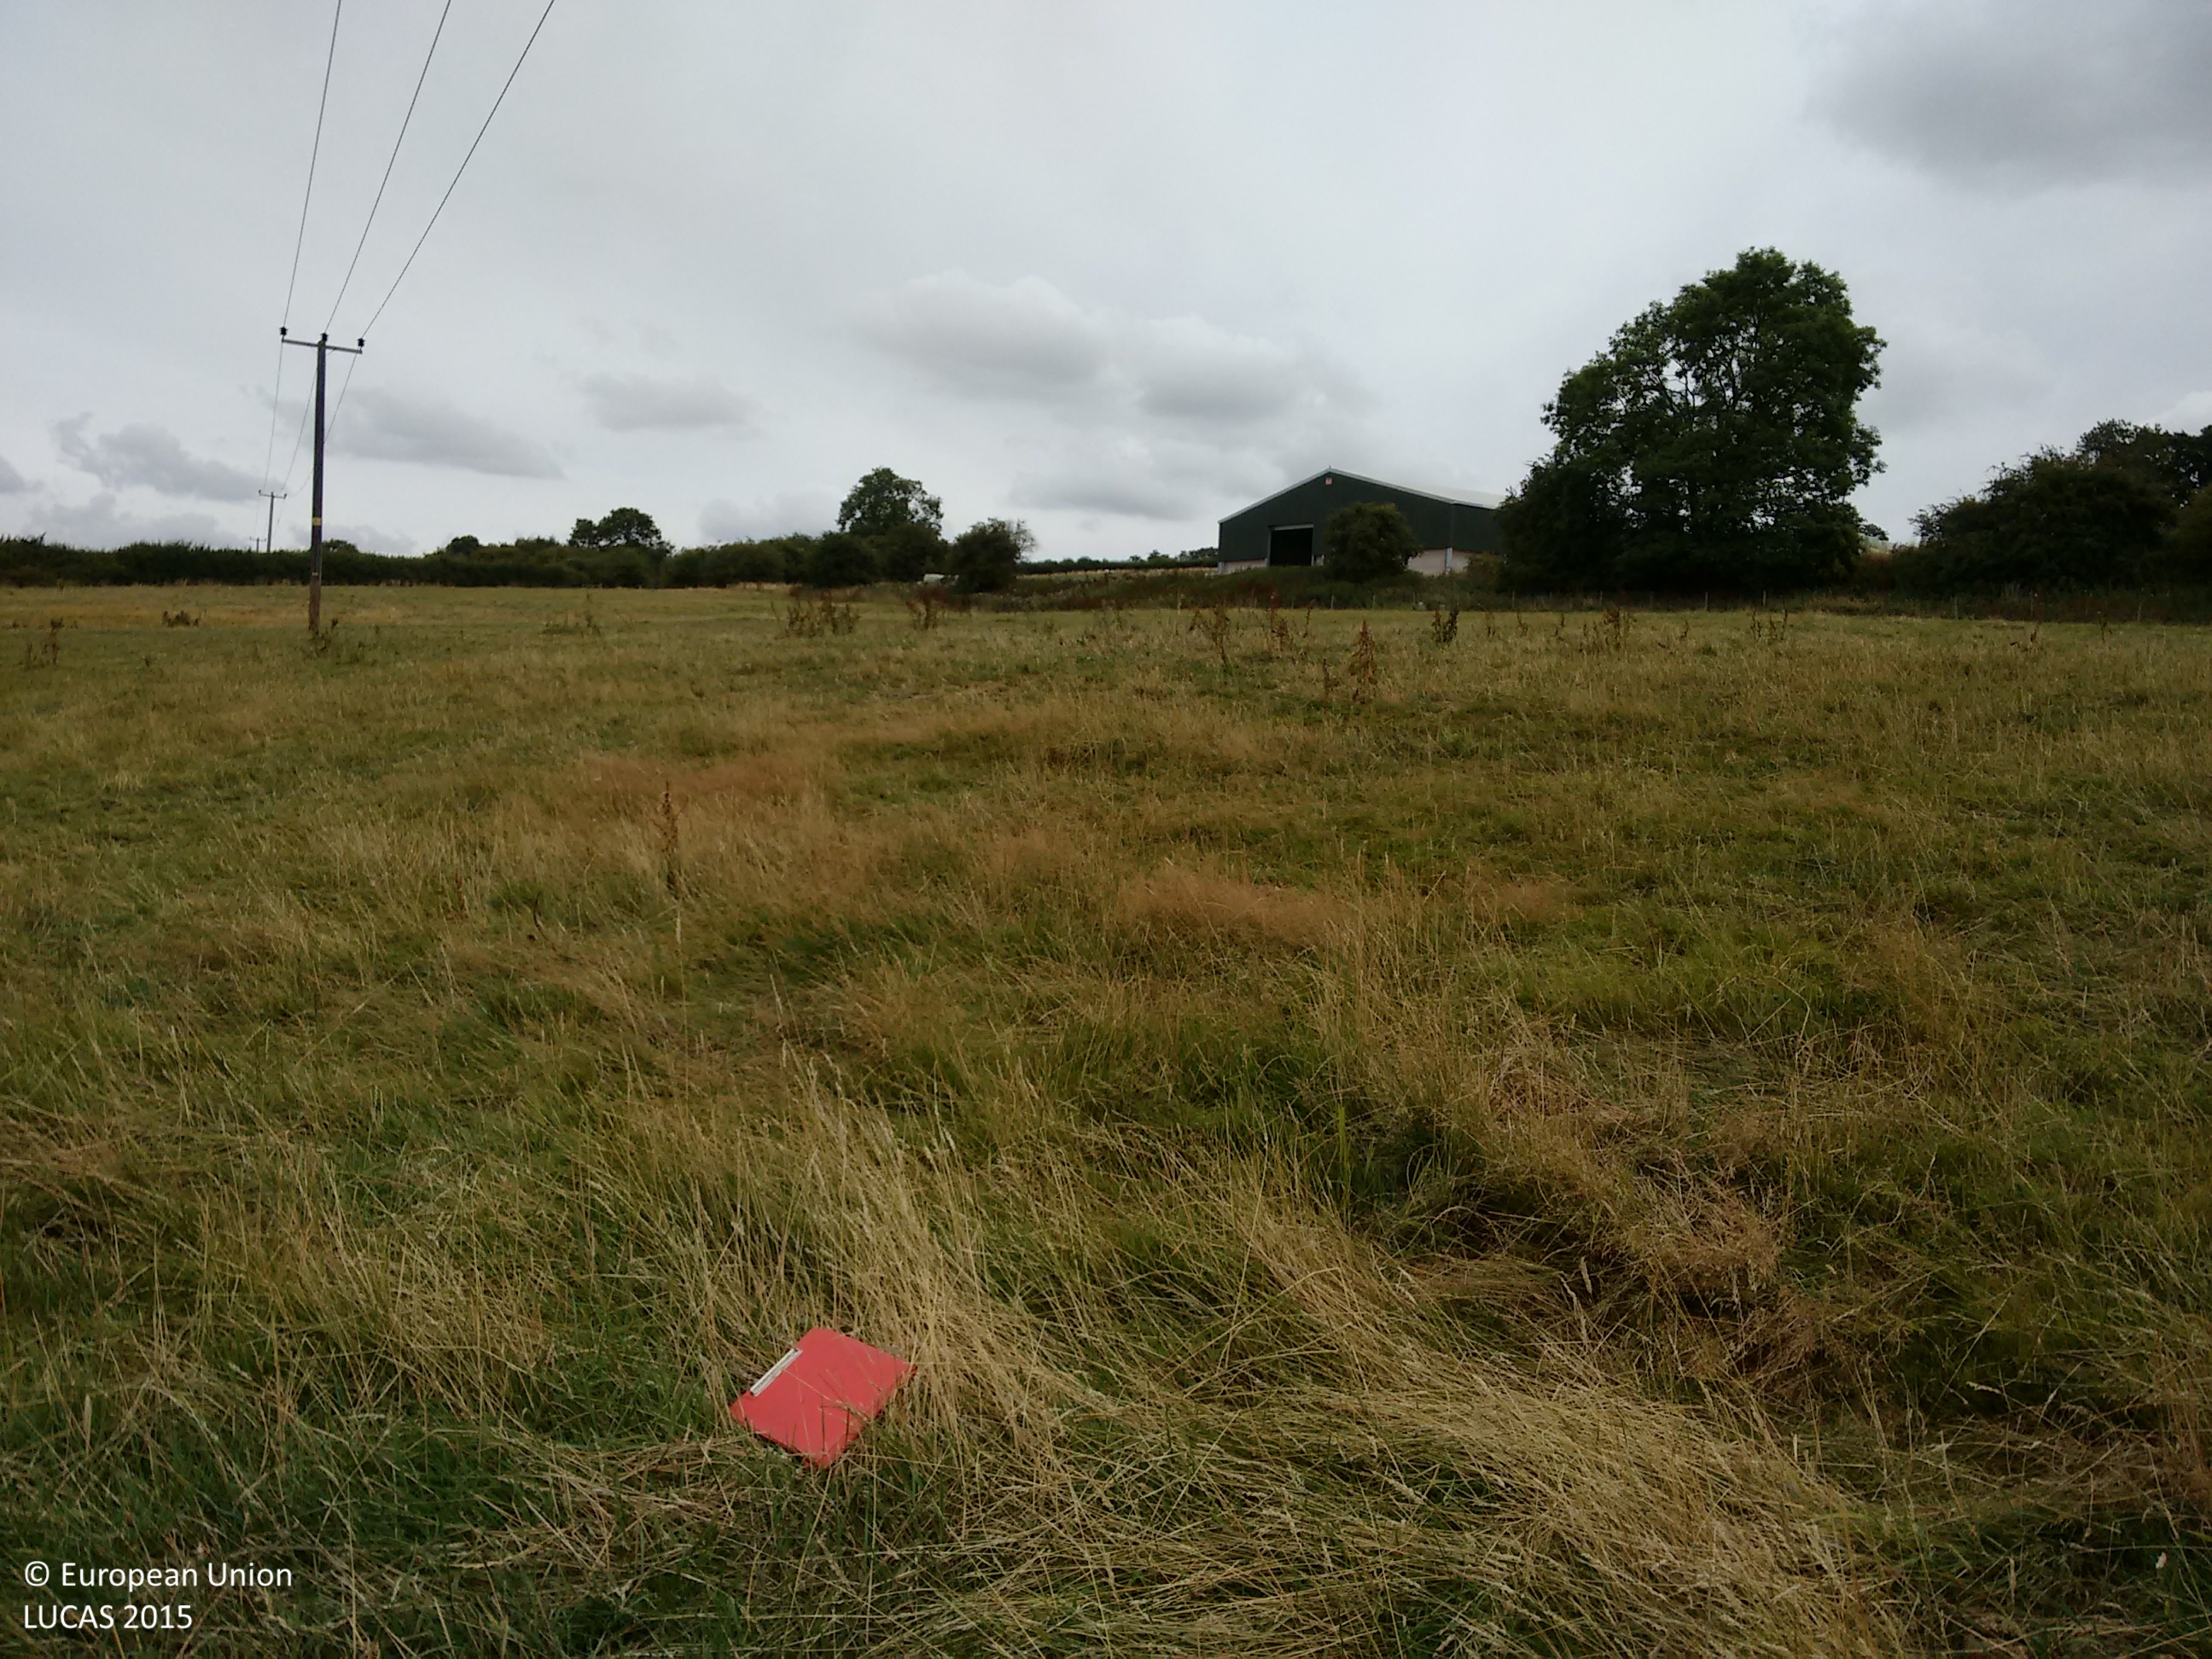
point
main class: Grassland
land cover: Grassland without tree/shrub cover
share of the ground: > 75 %
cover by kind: herbaceous plants 100 %
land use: Agriculture (excluding fallow land and kitchen gardens)
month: August
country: GB
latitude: 52.1161
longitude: -1.2191
